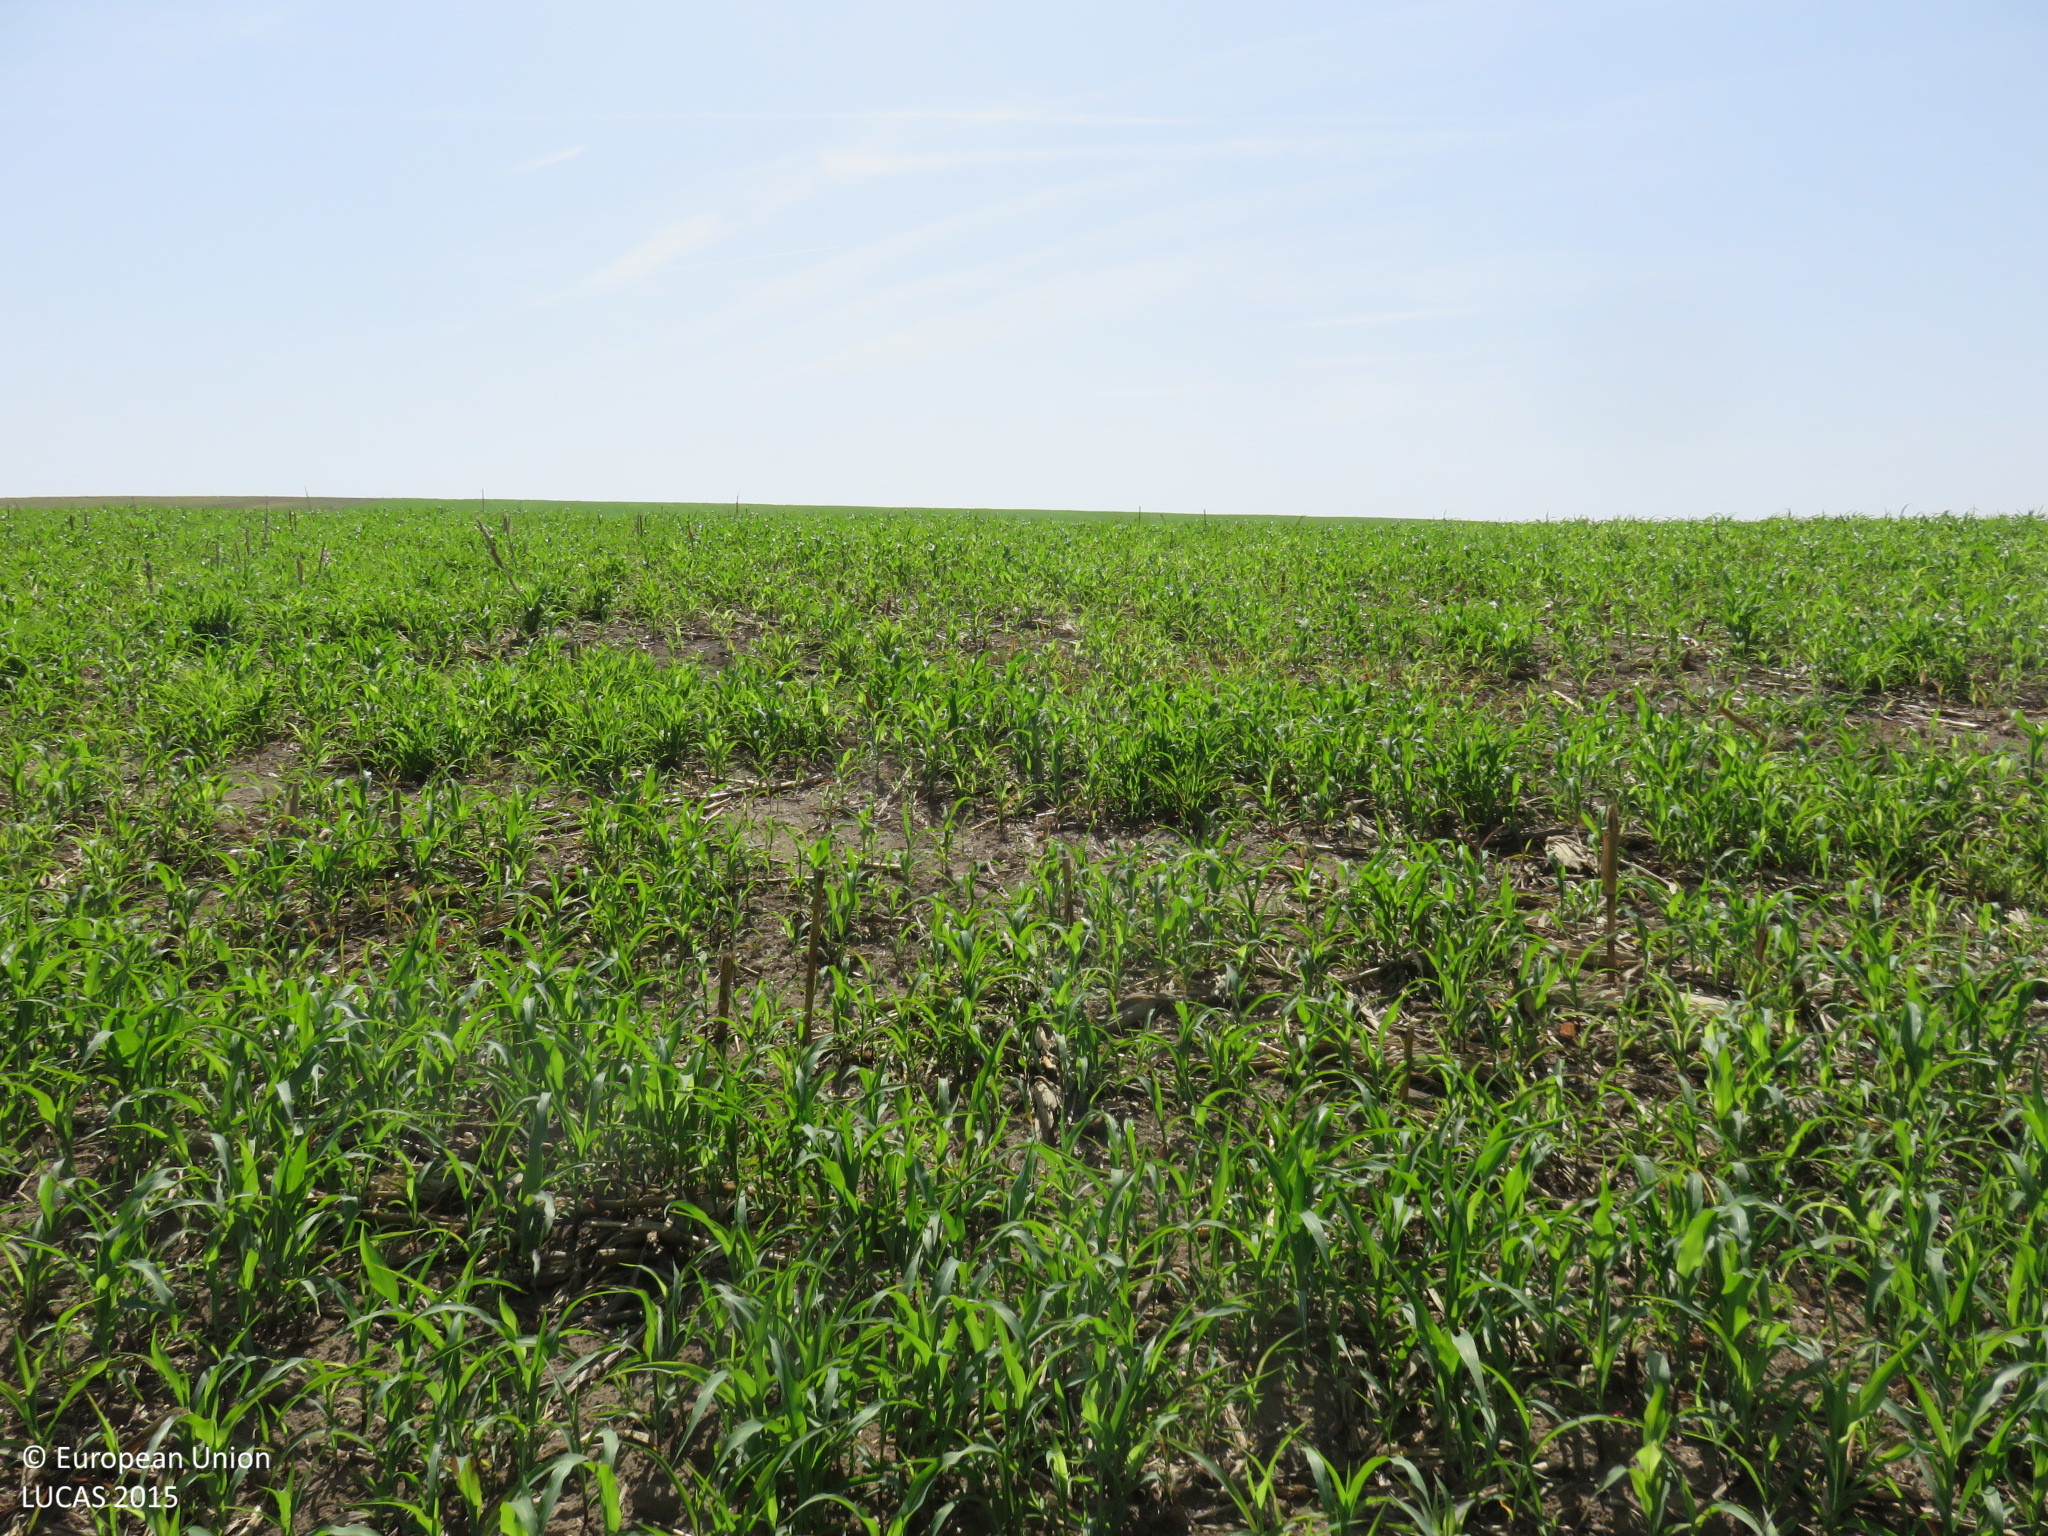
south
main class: Cropland
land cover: Maize
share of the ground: 25 - 50 %
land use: Agriculture (excluding fallow land and kitchen gardens)
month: September
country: BG
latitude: 43.5448
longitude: 24.6318
